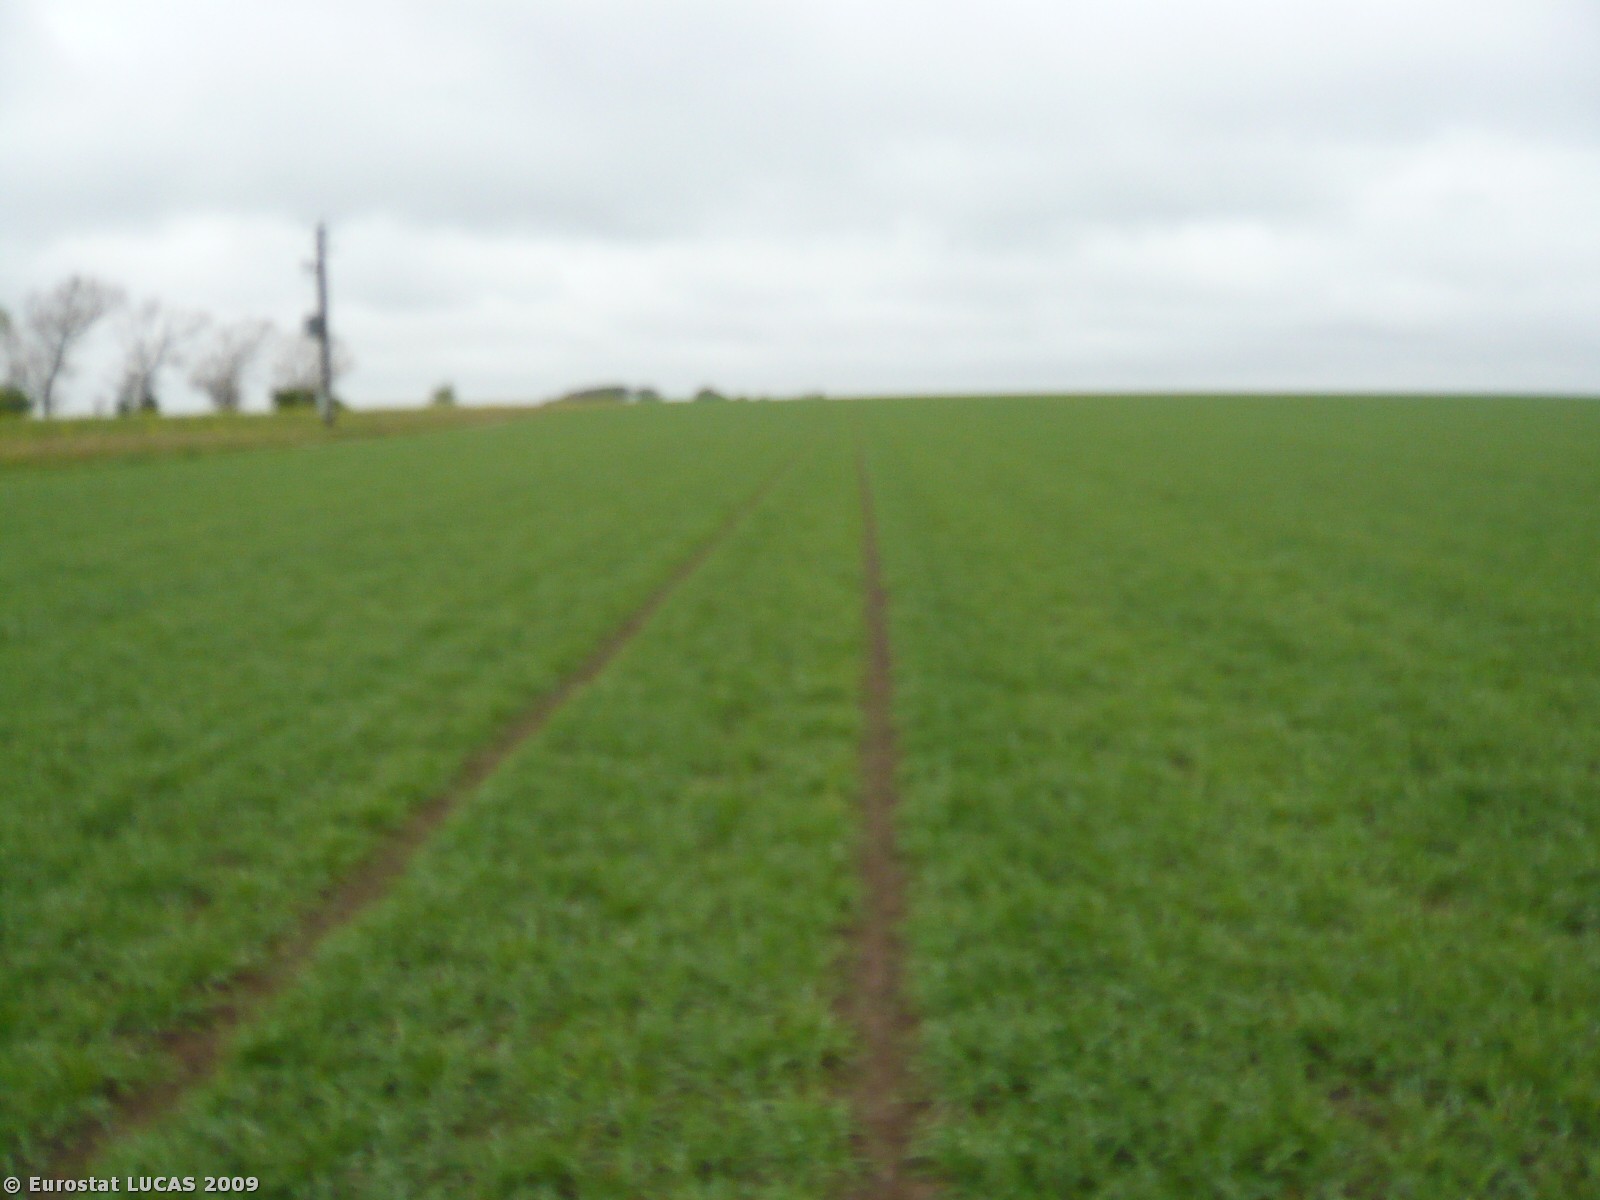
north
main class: Cropland
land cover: Barley
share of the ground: > 75 %
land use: Agriculture (excluding fallow land and kitchen gardens)
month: May
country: DK
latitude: 55.1319
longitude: 11.8338
